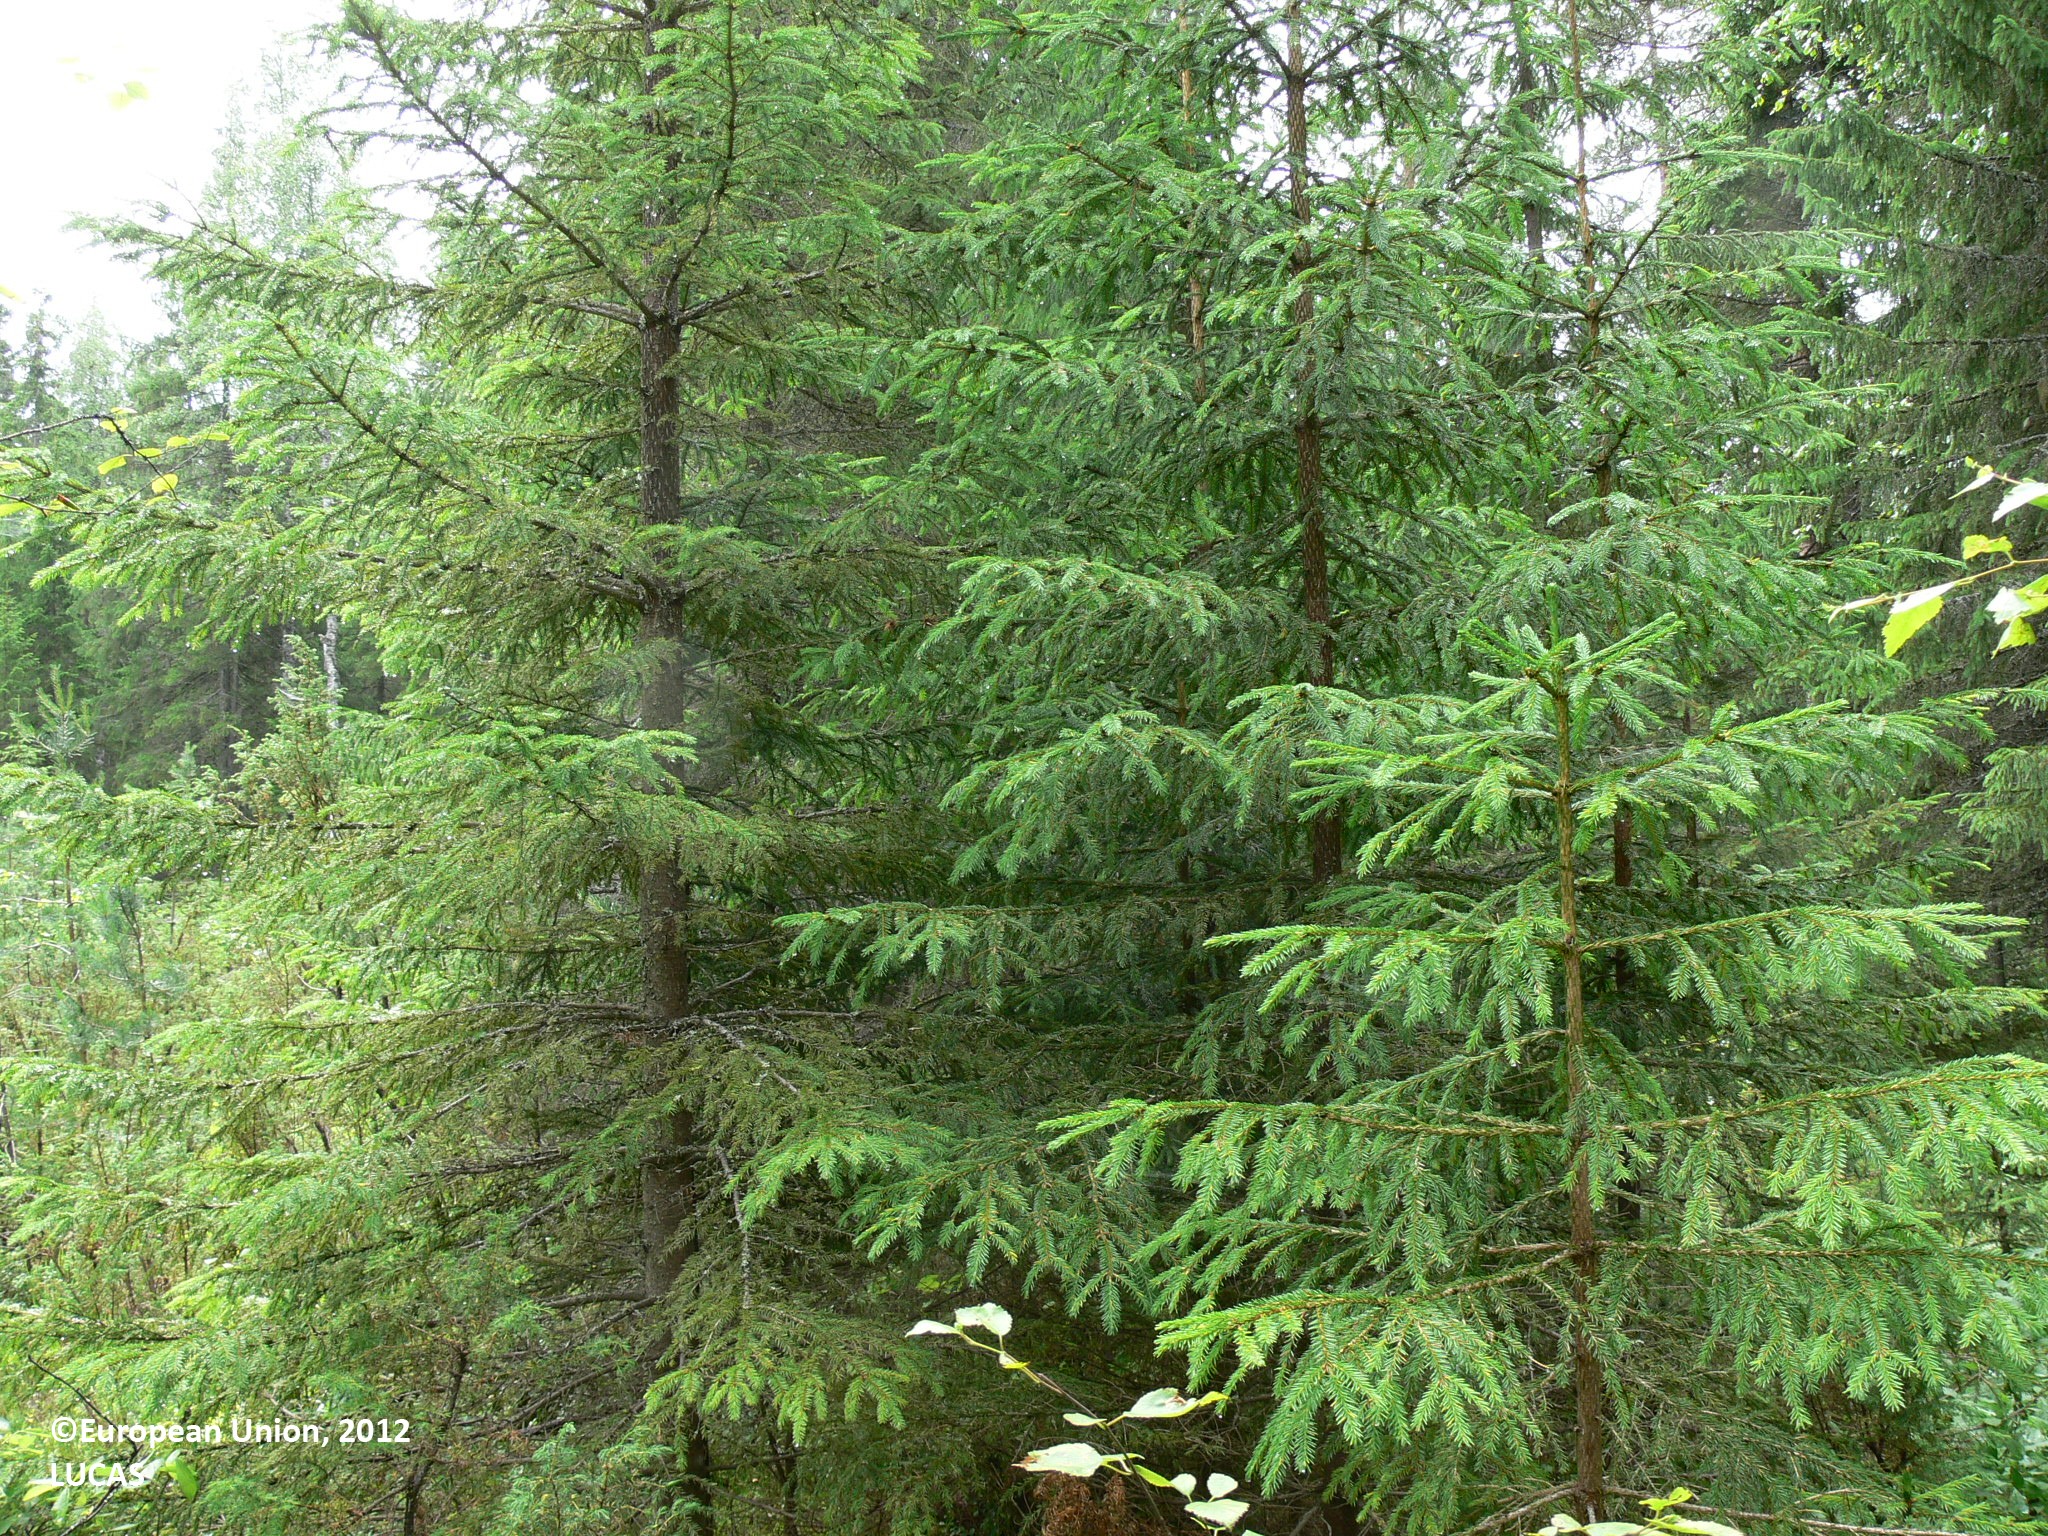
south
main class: Woodland
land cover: Spruce dominated coniferous woodland
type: boreal forest
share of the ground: 50 - 75 %
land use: Forestry
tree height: > 5 m
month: July
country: FI
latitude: 63.0872
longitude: 29.5418
